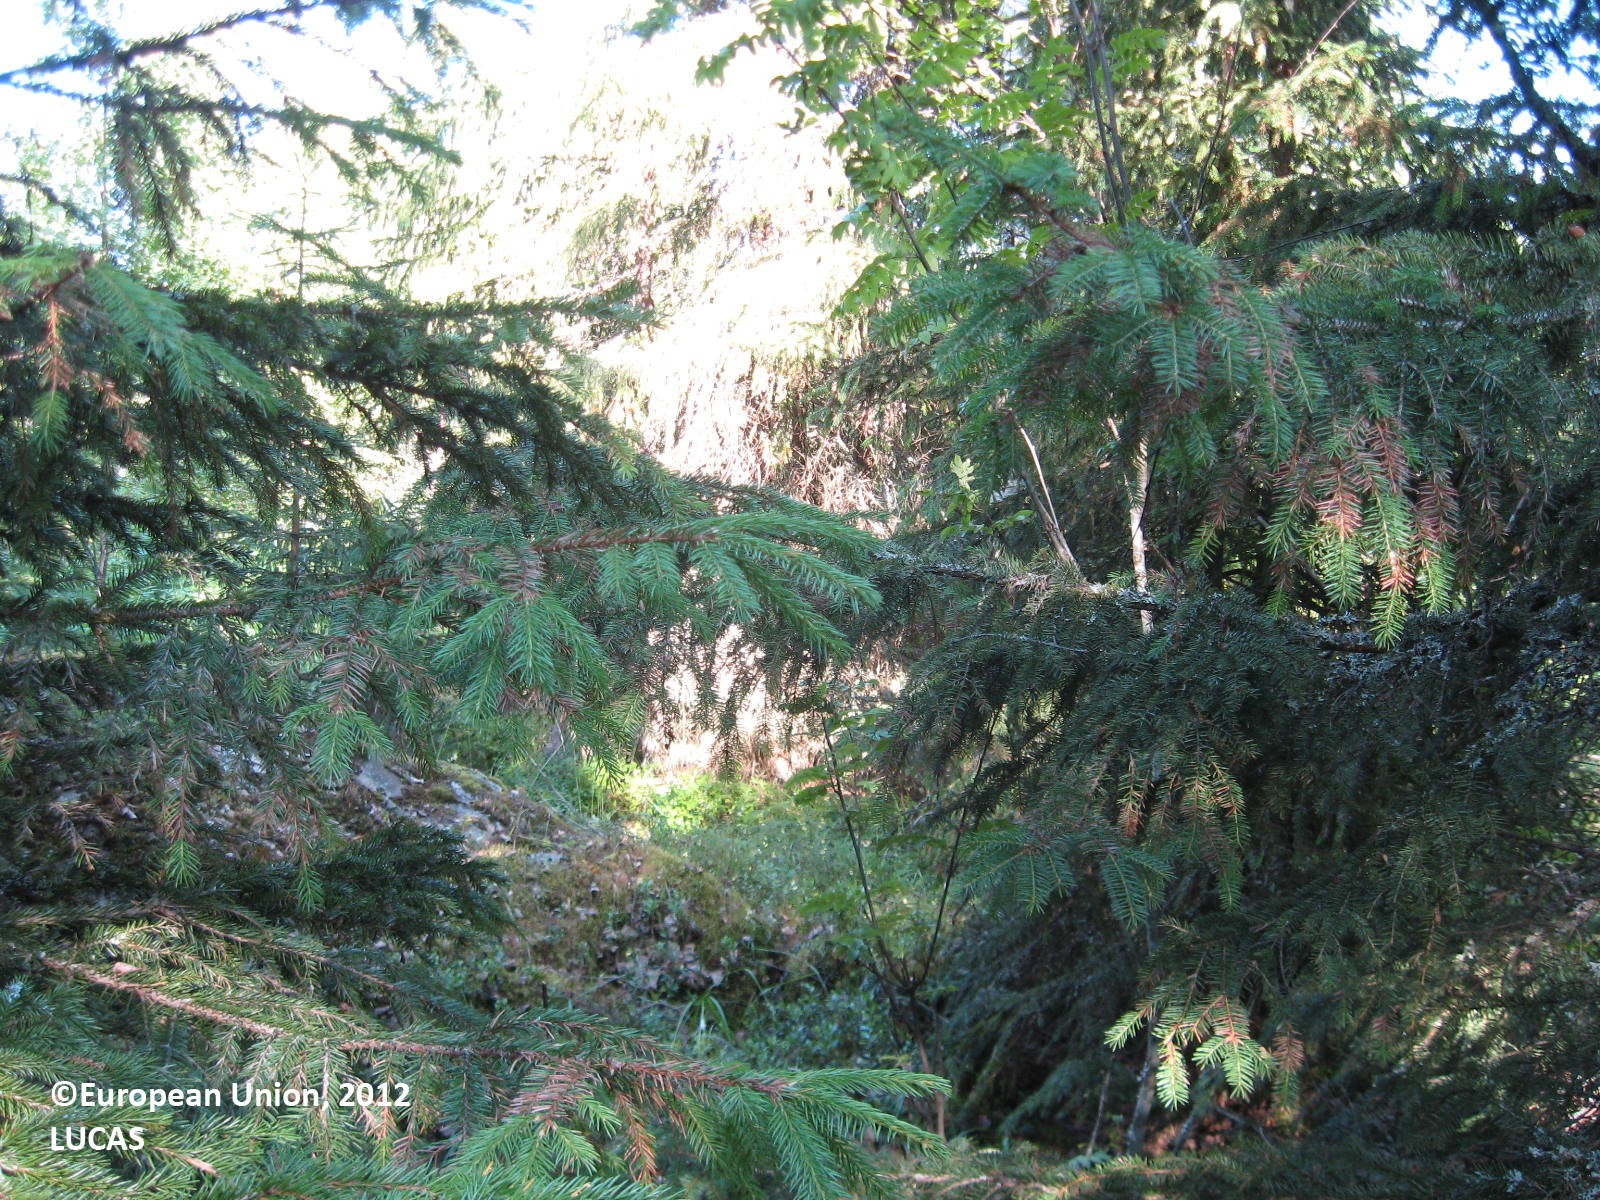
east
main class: Woodland
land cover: Spruce dominated coniferous woodland
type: boreal forest
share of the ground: > 75 %
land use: Forestry
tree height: > 5 m
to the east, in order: Spruce dominated coniferous woodland; Pine dominated mixed woodland
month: July
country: FI
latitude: 62.1696
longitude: 21.5086
